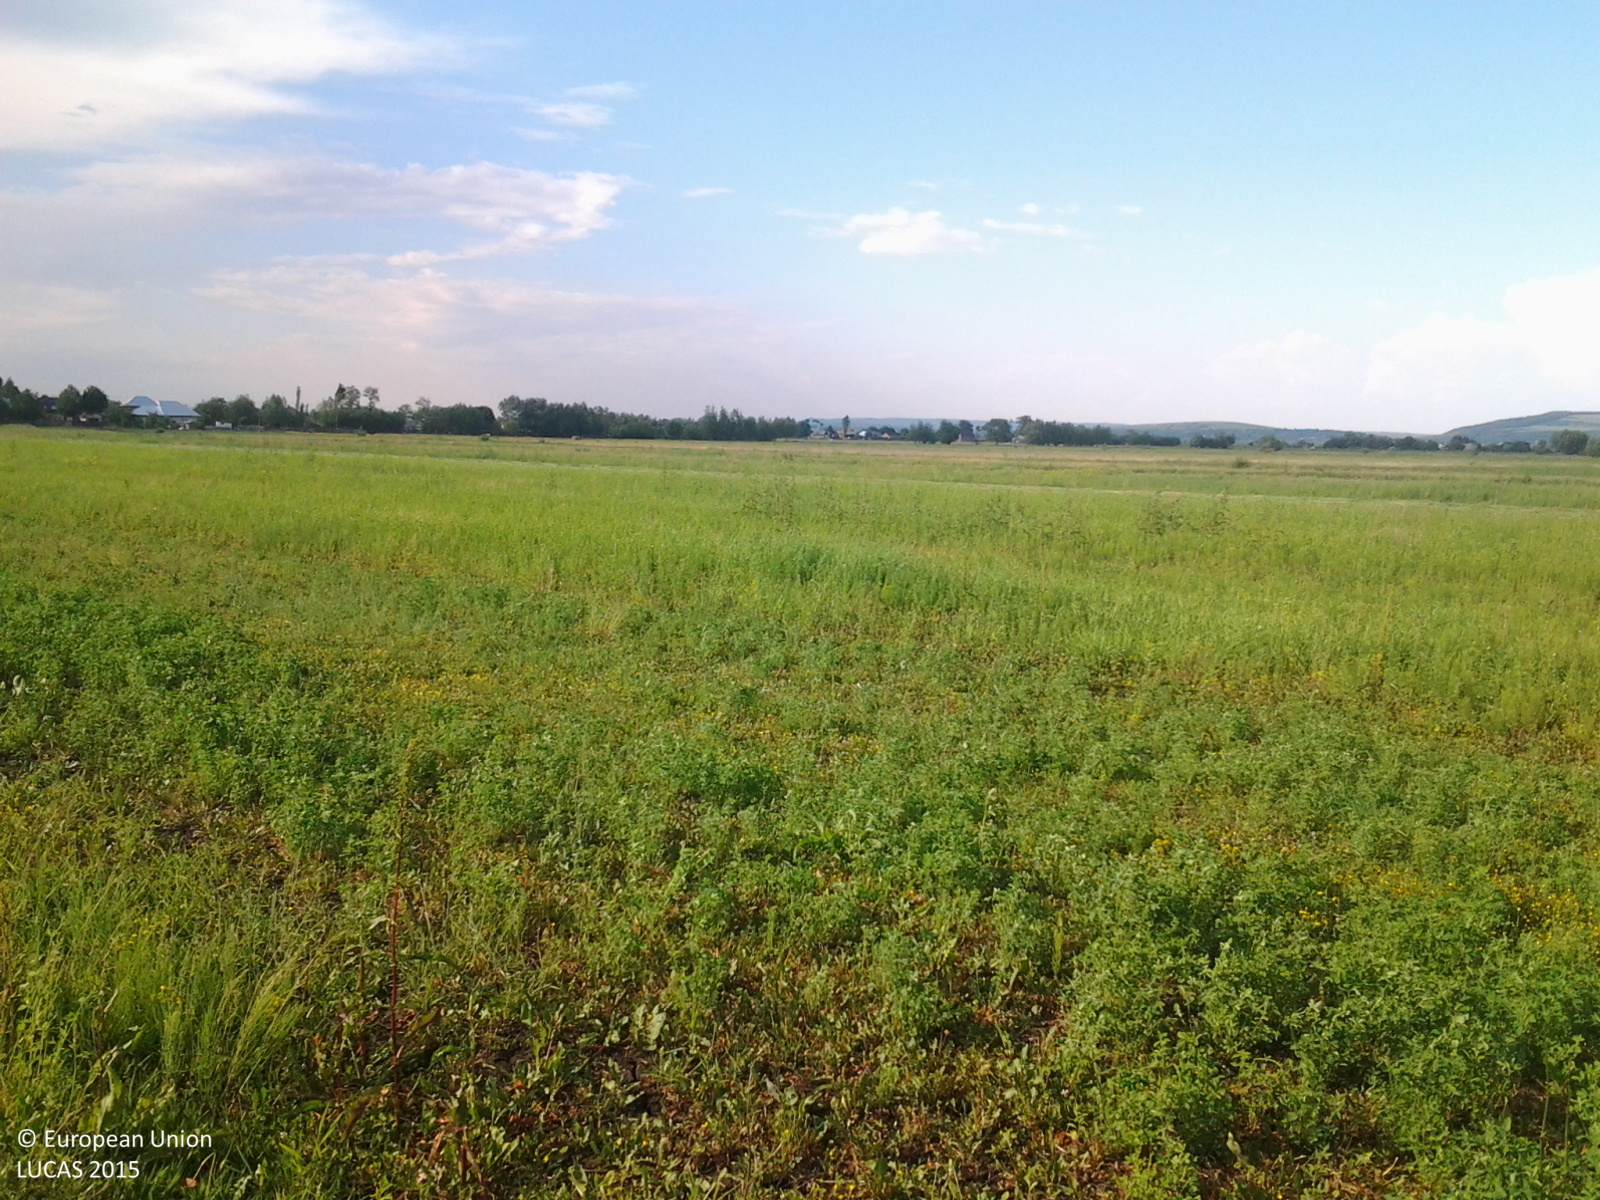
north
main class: Cropland
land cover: Lucerne
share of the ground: > 75 %
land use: Agriculture (excluding fallow land and kitchen gardens)
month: June
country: RO
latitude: 46.7346
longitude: 26.5883
